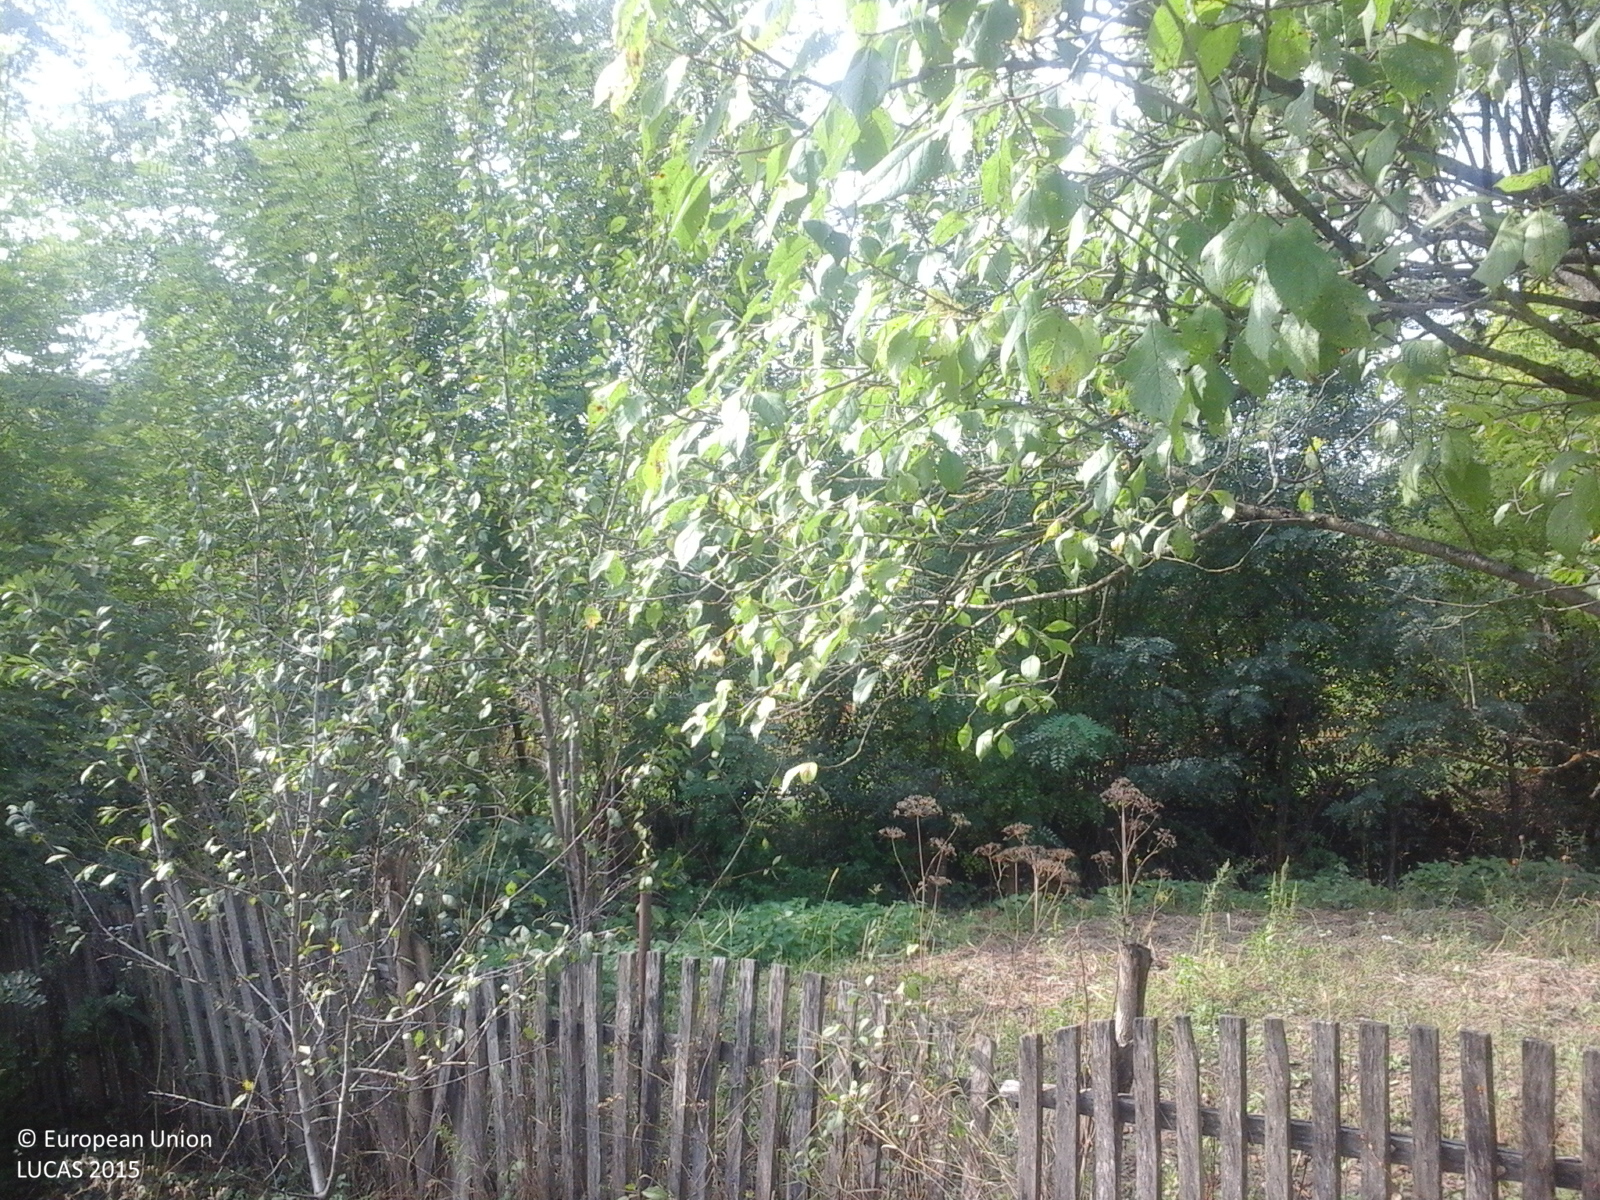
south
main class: Cropland
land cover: Maize
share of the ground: > 75 %
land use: Kitchen garden
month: September
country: RO
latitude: 47.1052
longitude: 23.2842
